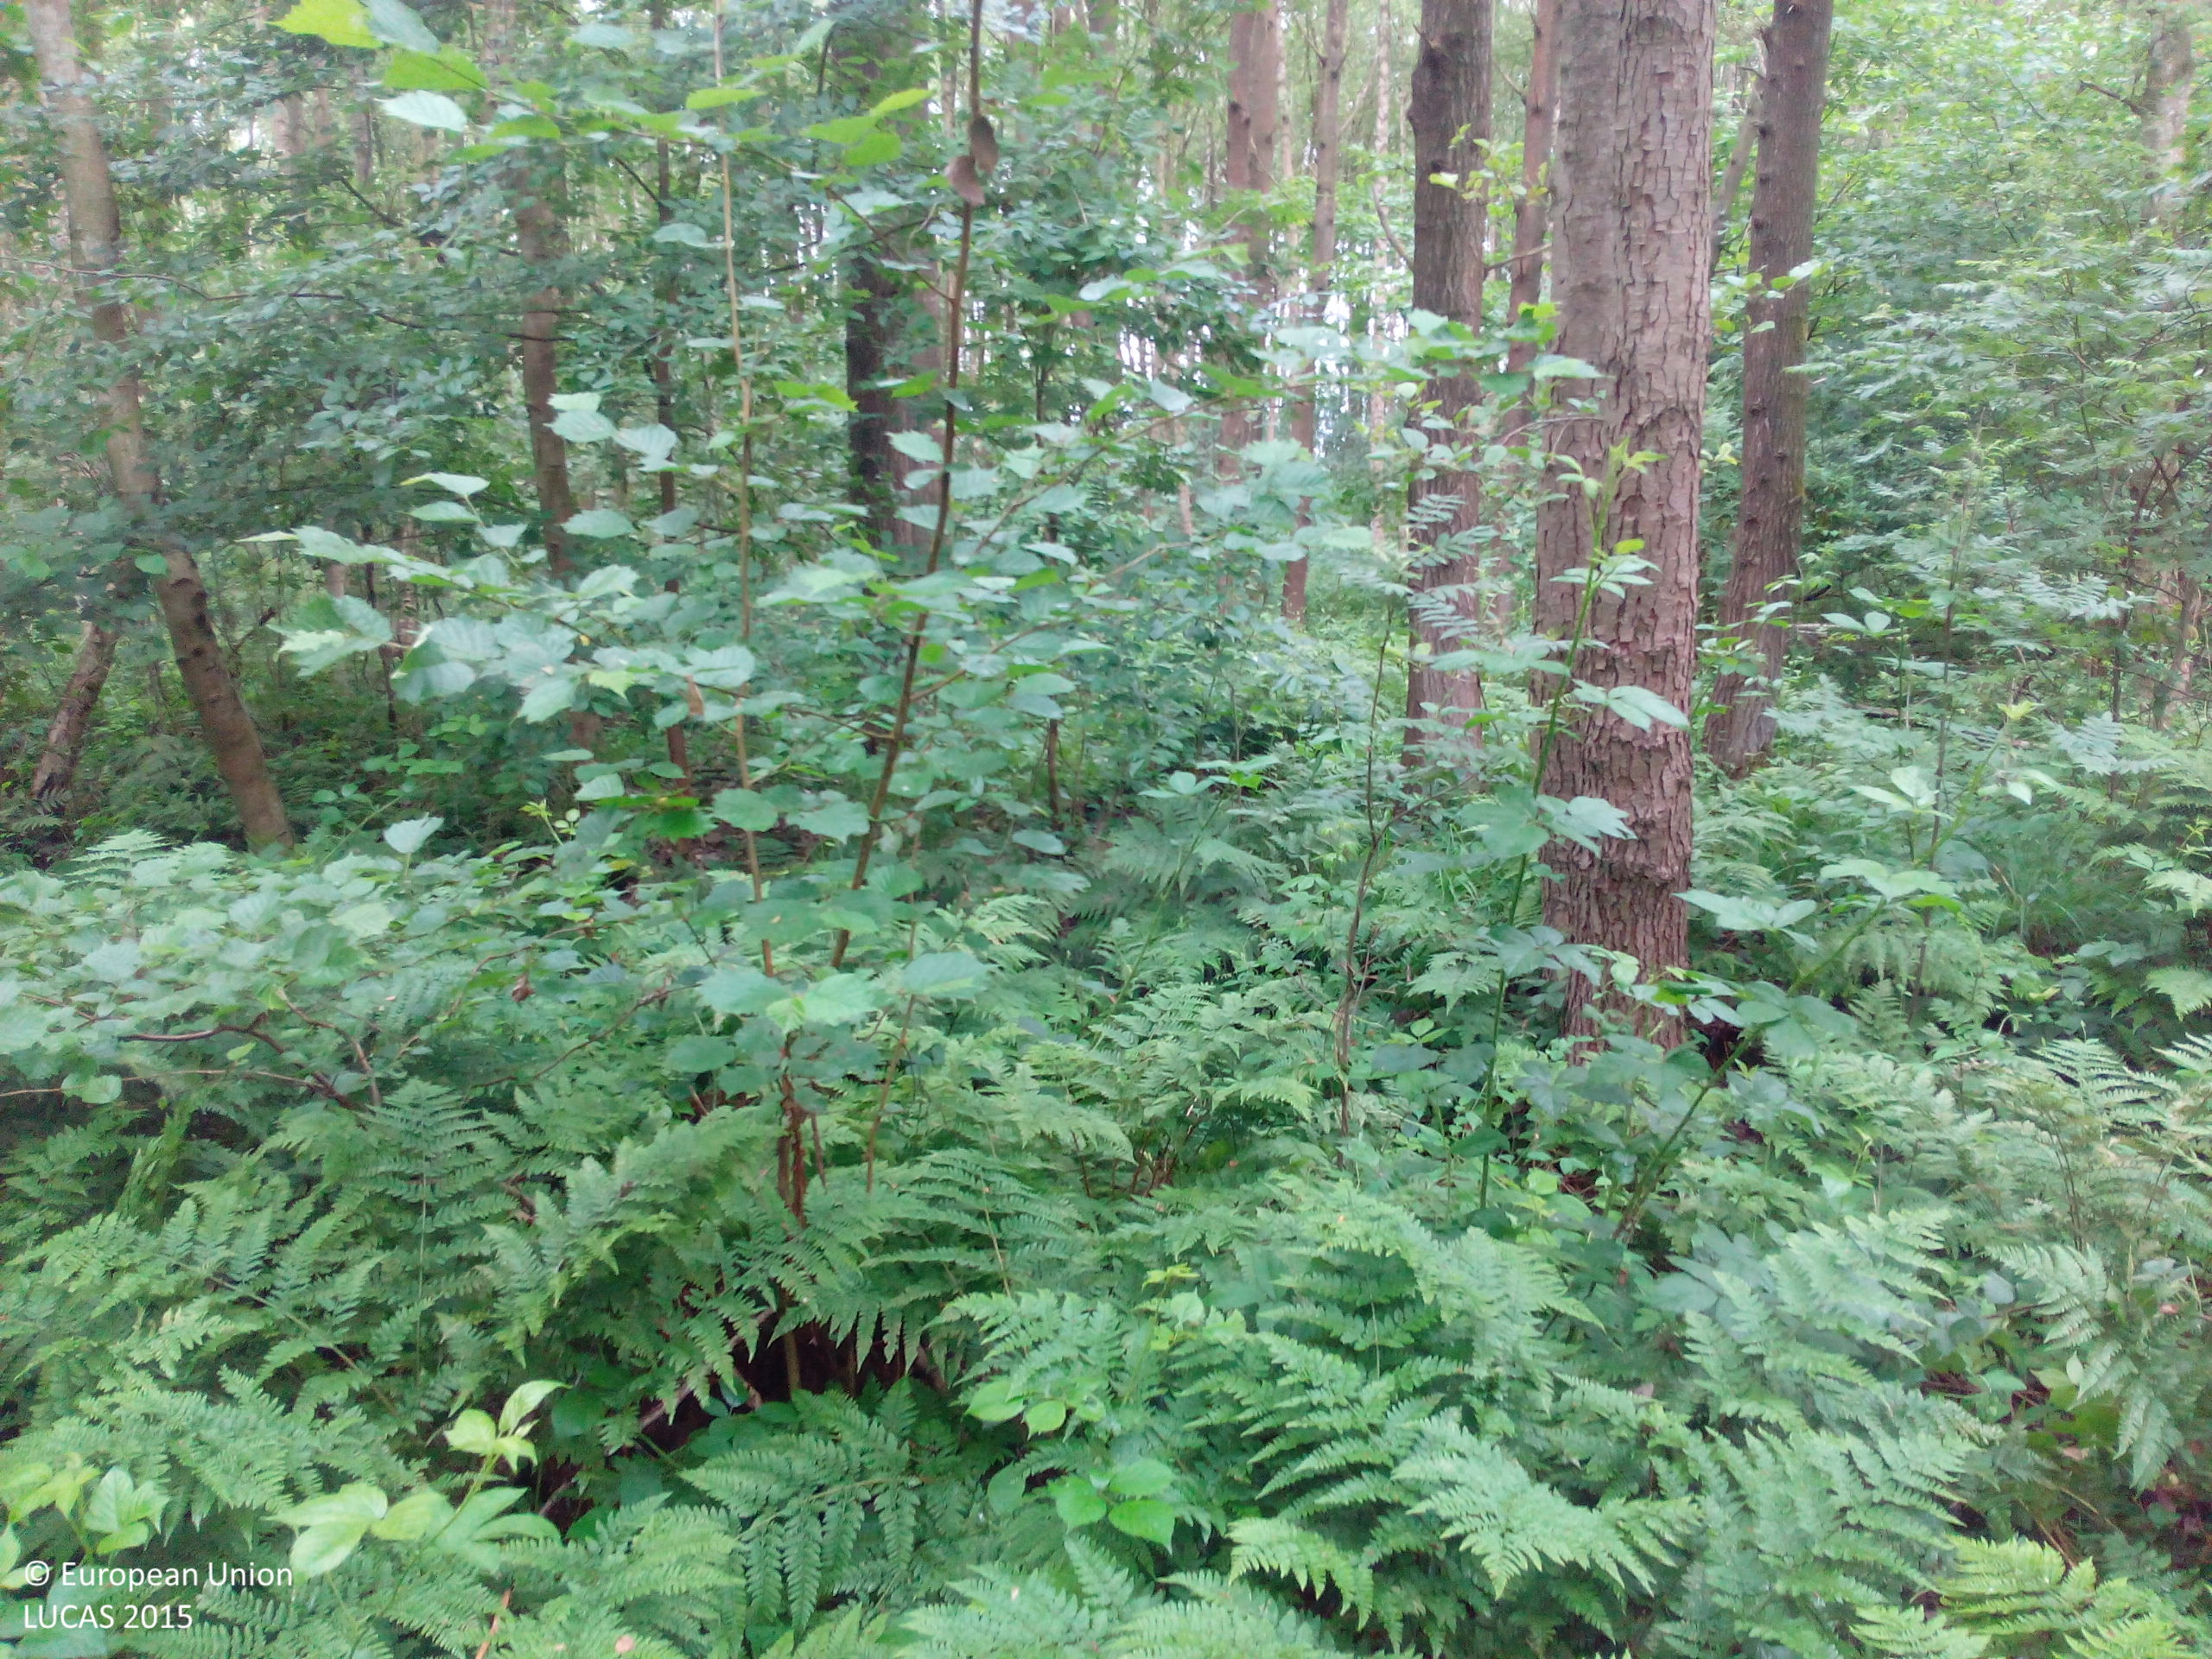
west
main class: Woodland
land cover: Broadleaved woodland
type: non-riverine alder, birch or aspen forest
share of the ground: > 75 %
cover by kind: broadleaved forest trees 95 %, shrubs 5 %
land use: Forestry
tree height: > 5 m
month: June
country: DE
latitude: 52.4310
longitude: 10.2793
